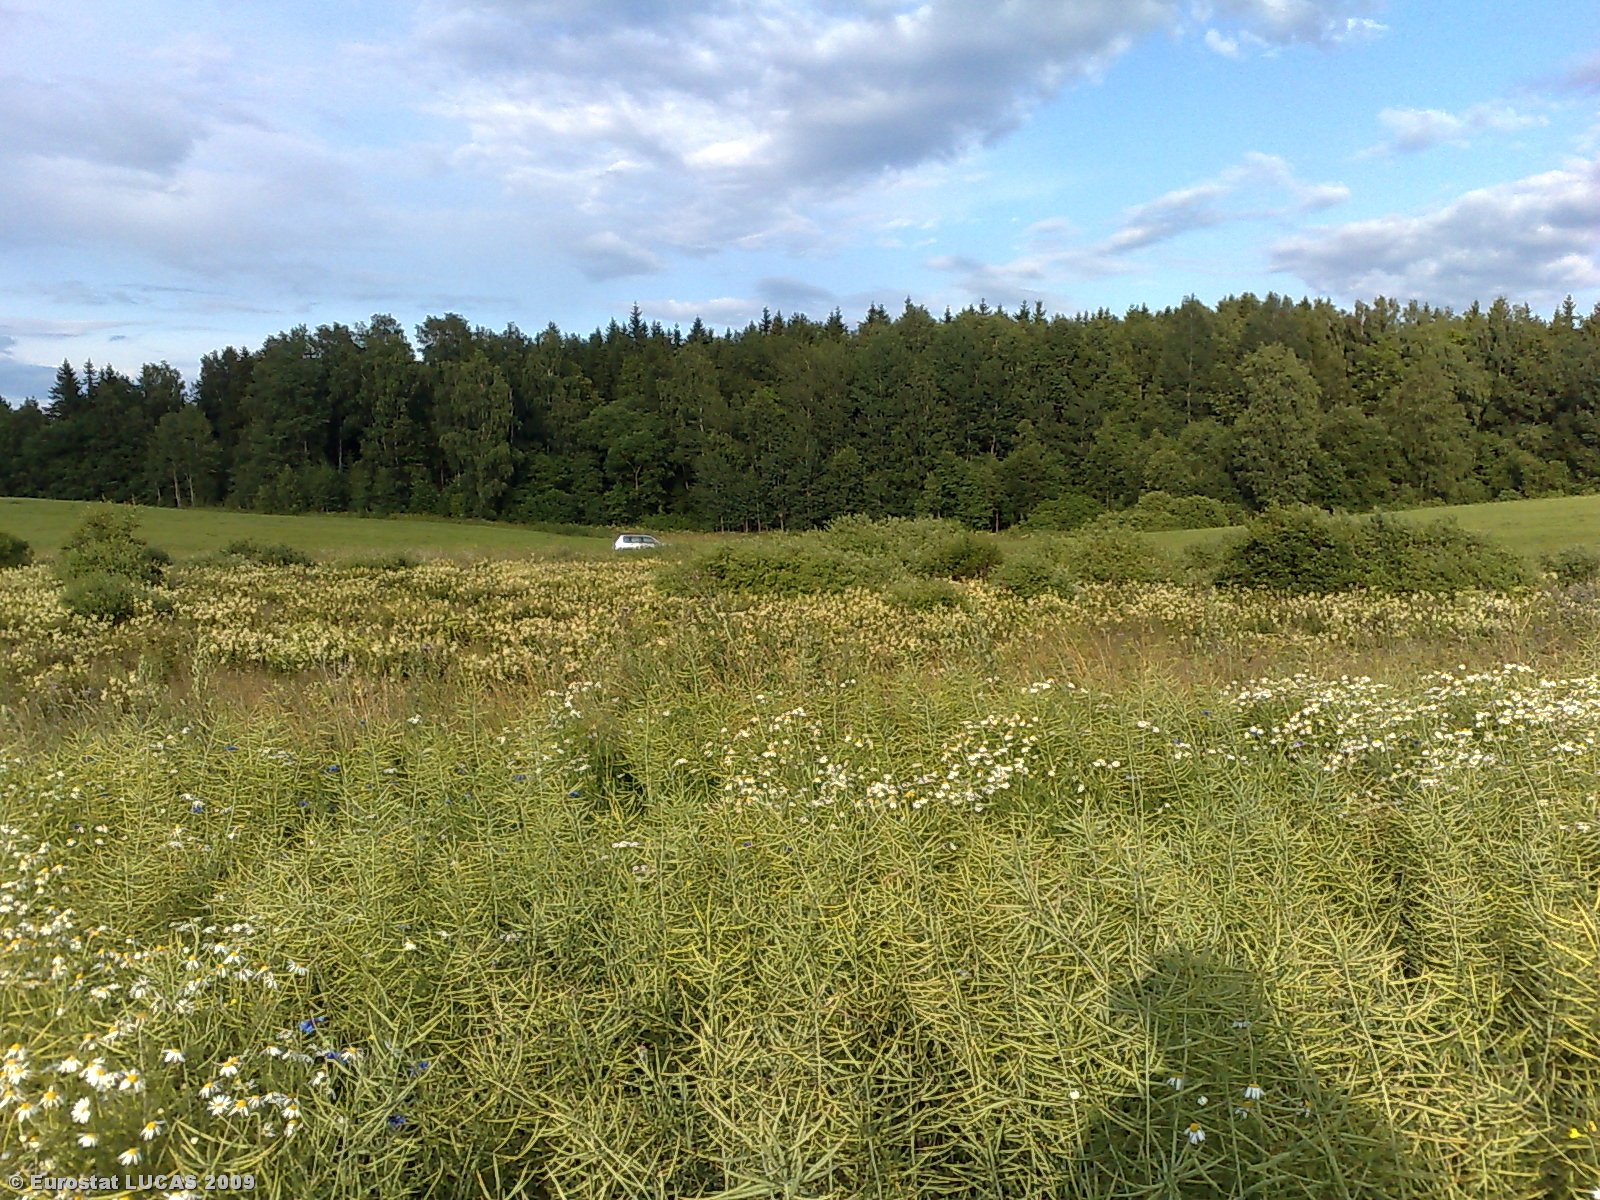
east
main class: Cropland
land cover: Rape and turnip rape
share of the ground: > 75 %
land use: Agriculture (excluding fallow land and kitchen gardens)
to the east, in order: Rape and turnip rape; Grassland without tree/shrub cover; Broadleaved woodland
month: July
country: LT
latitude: 55.6500
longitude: 22.8267
